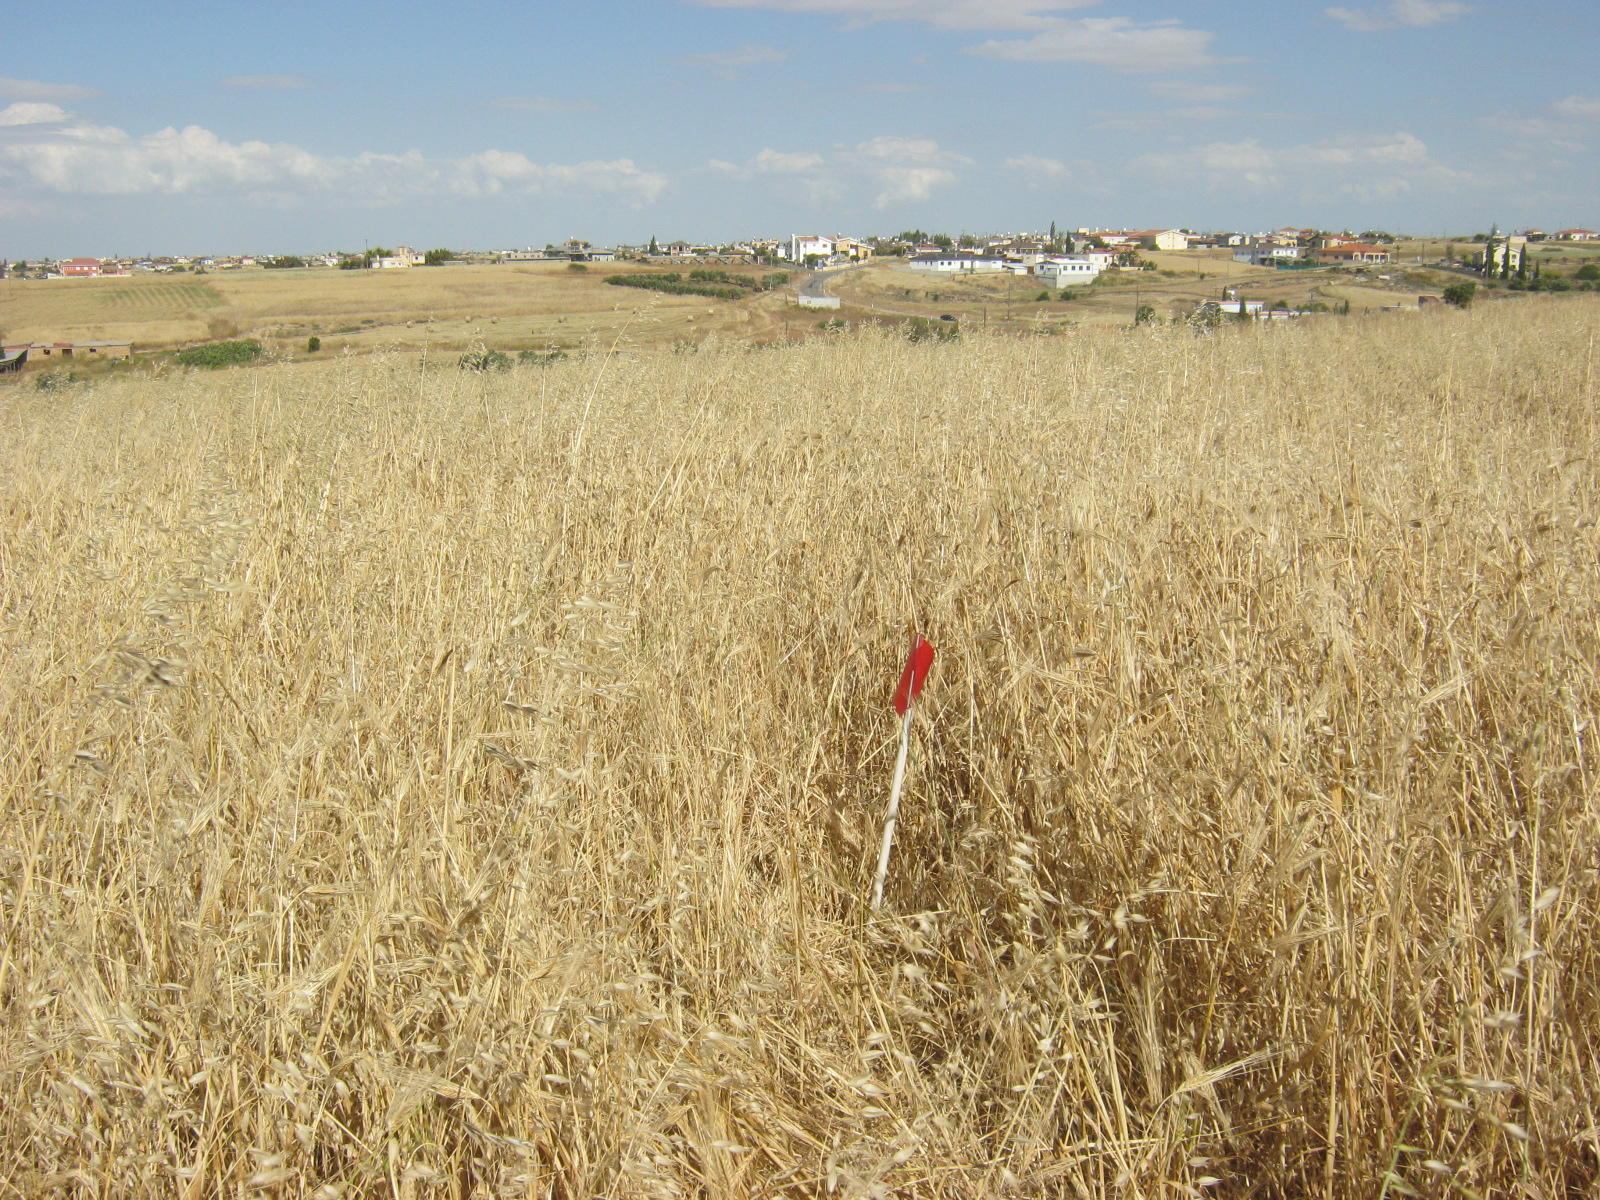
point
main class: Cropland
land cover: Barley
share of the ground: > 75 %
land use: Agriculture (excluding fallow land and kitchen gardens)
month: May
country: CY
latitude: 35.1244
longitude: 33.1742
